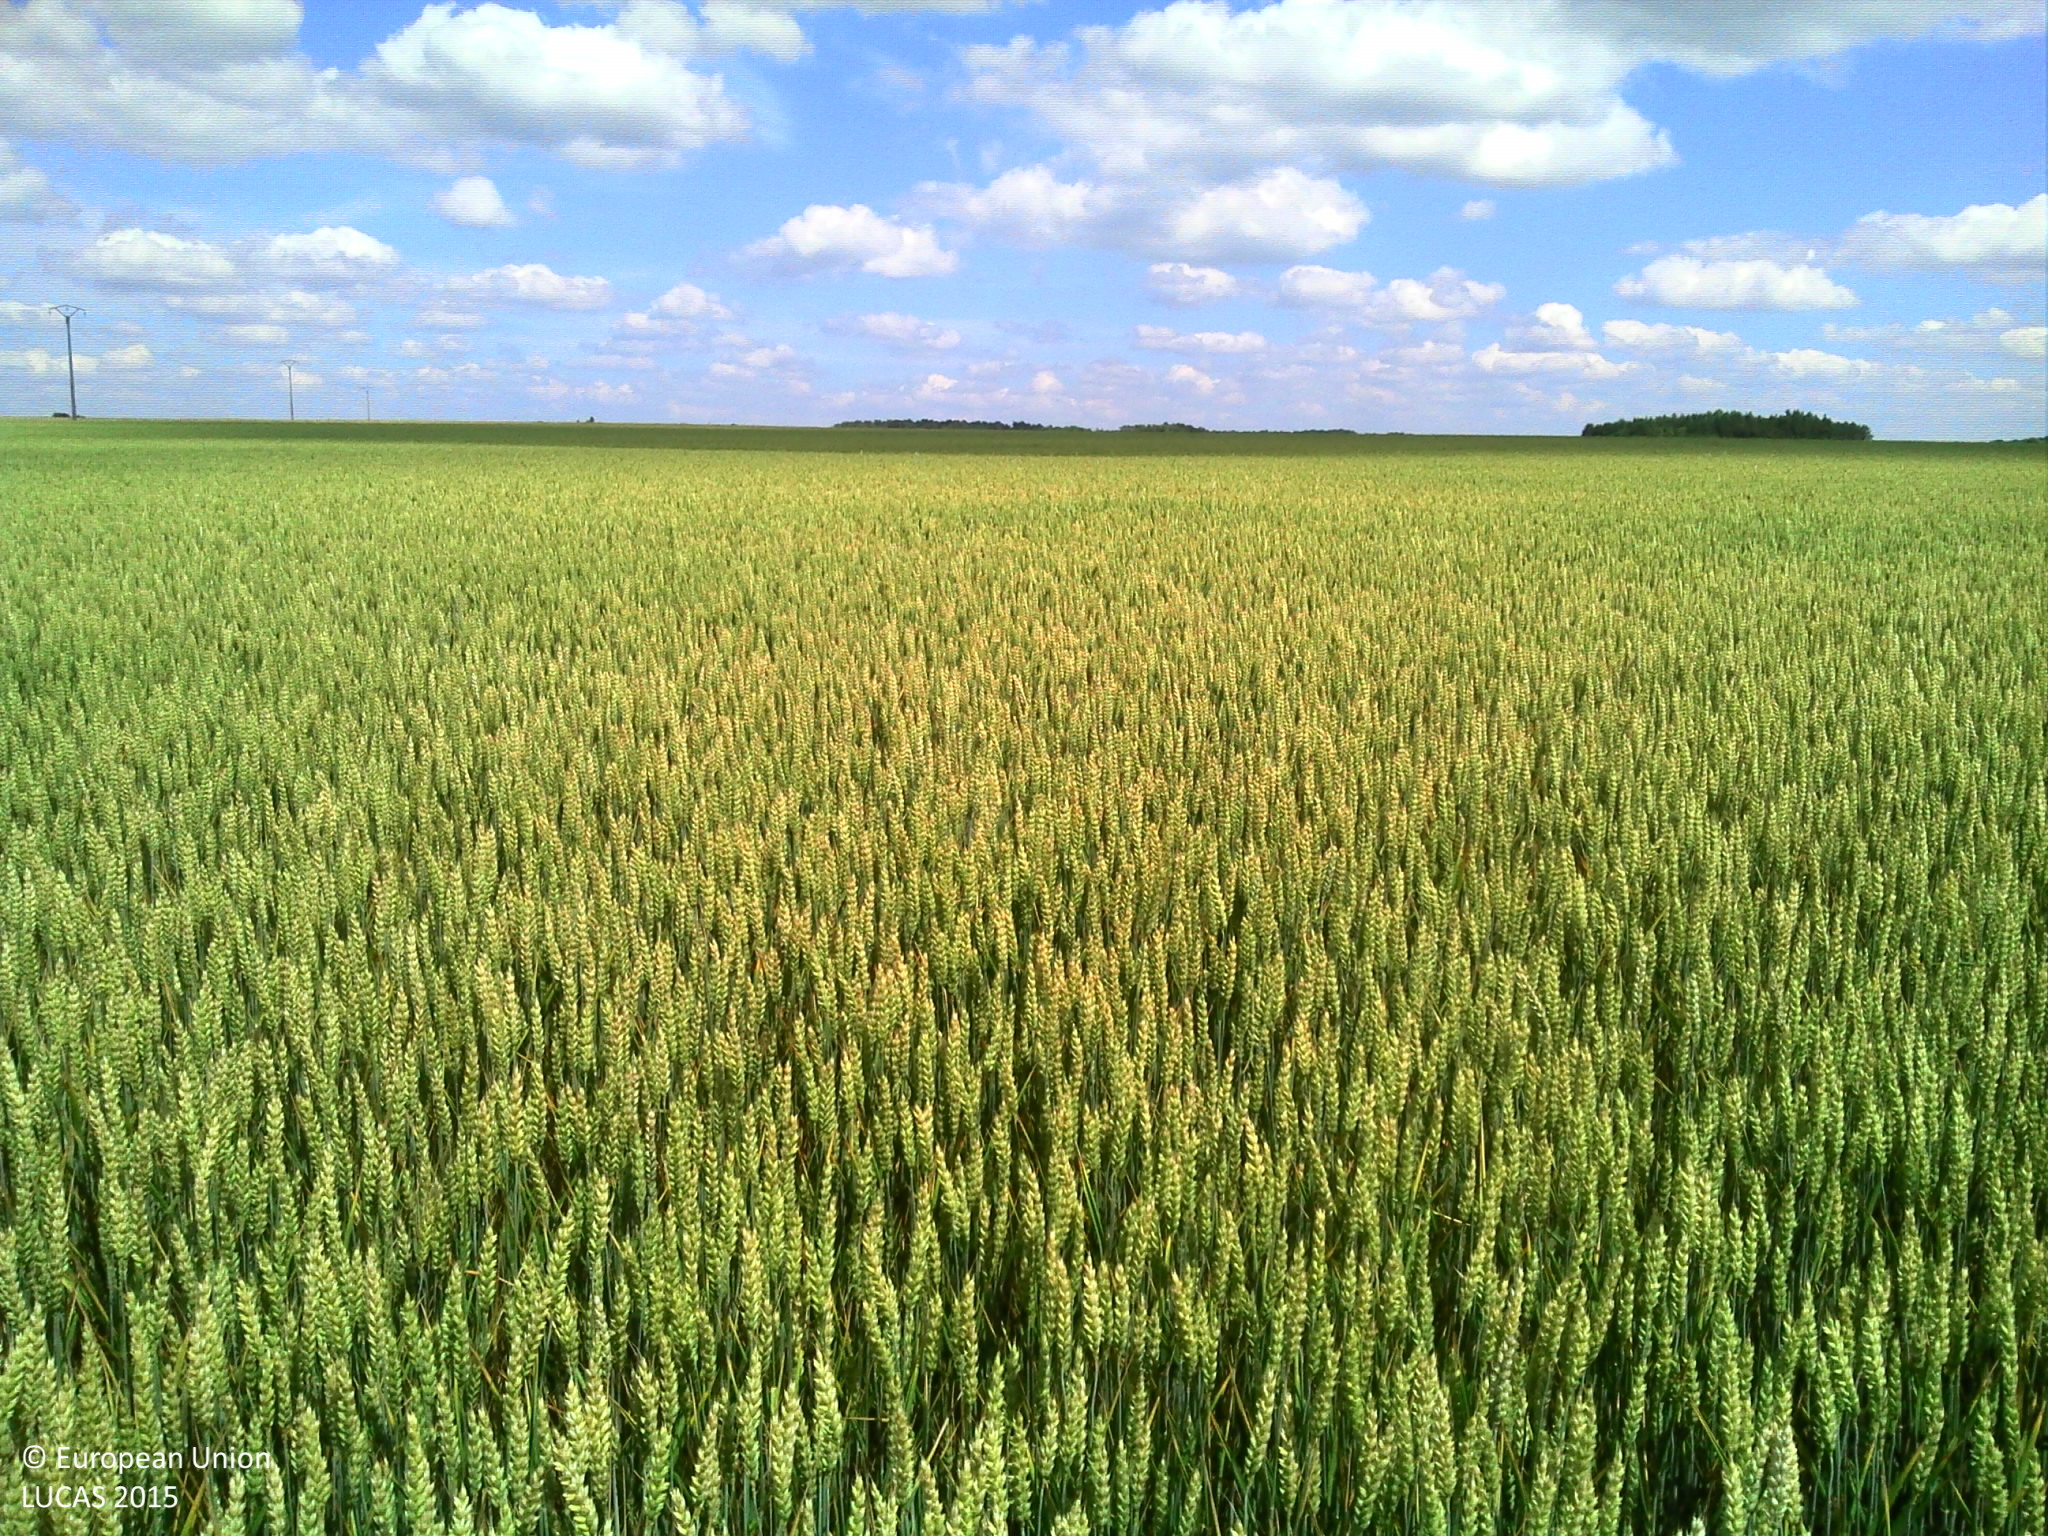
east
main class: Cropland
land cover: Common wheat
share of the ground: > 75 %
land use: Agriculture (excluding fallow land and kitchen gardens)
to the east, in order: Common wheat; Barley
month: June
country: FR
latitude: 49.0484
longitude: 5.9085
